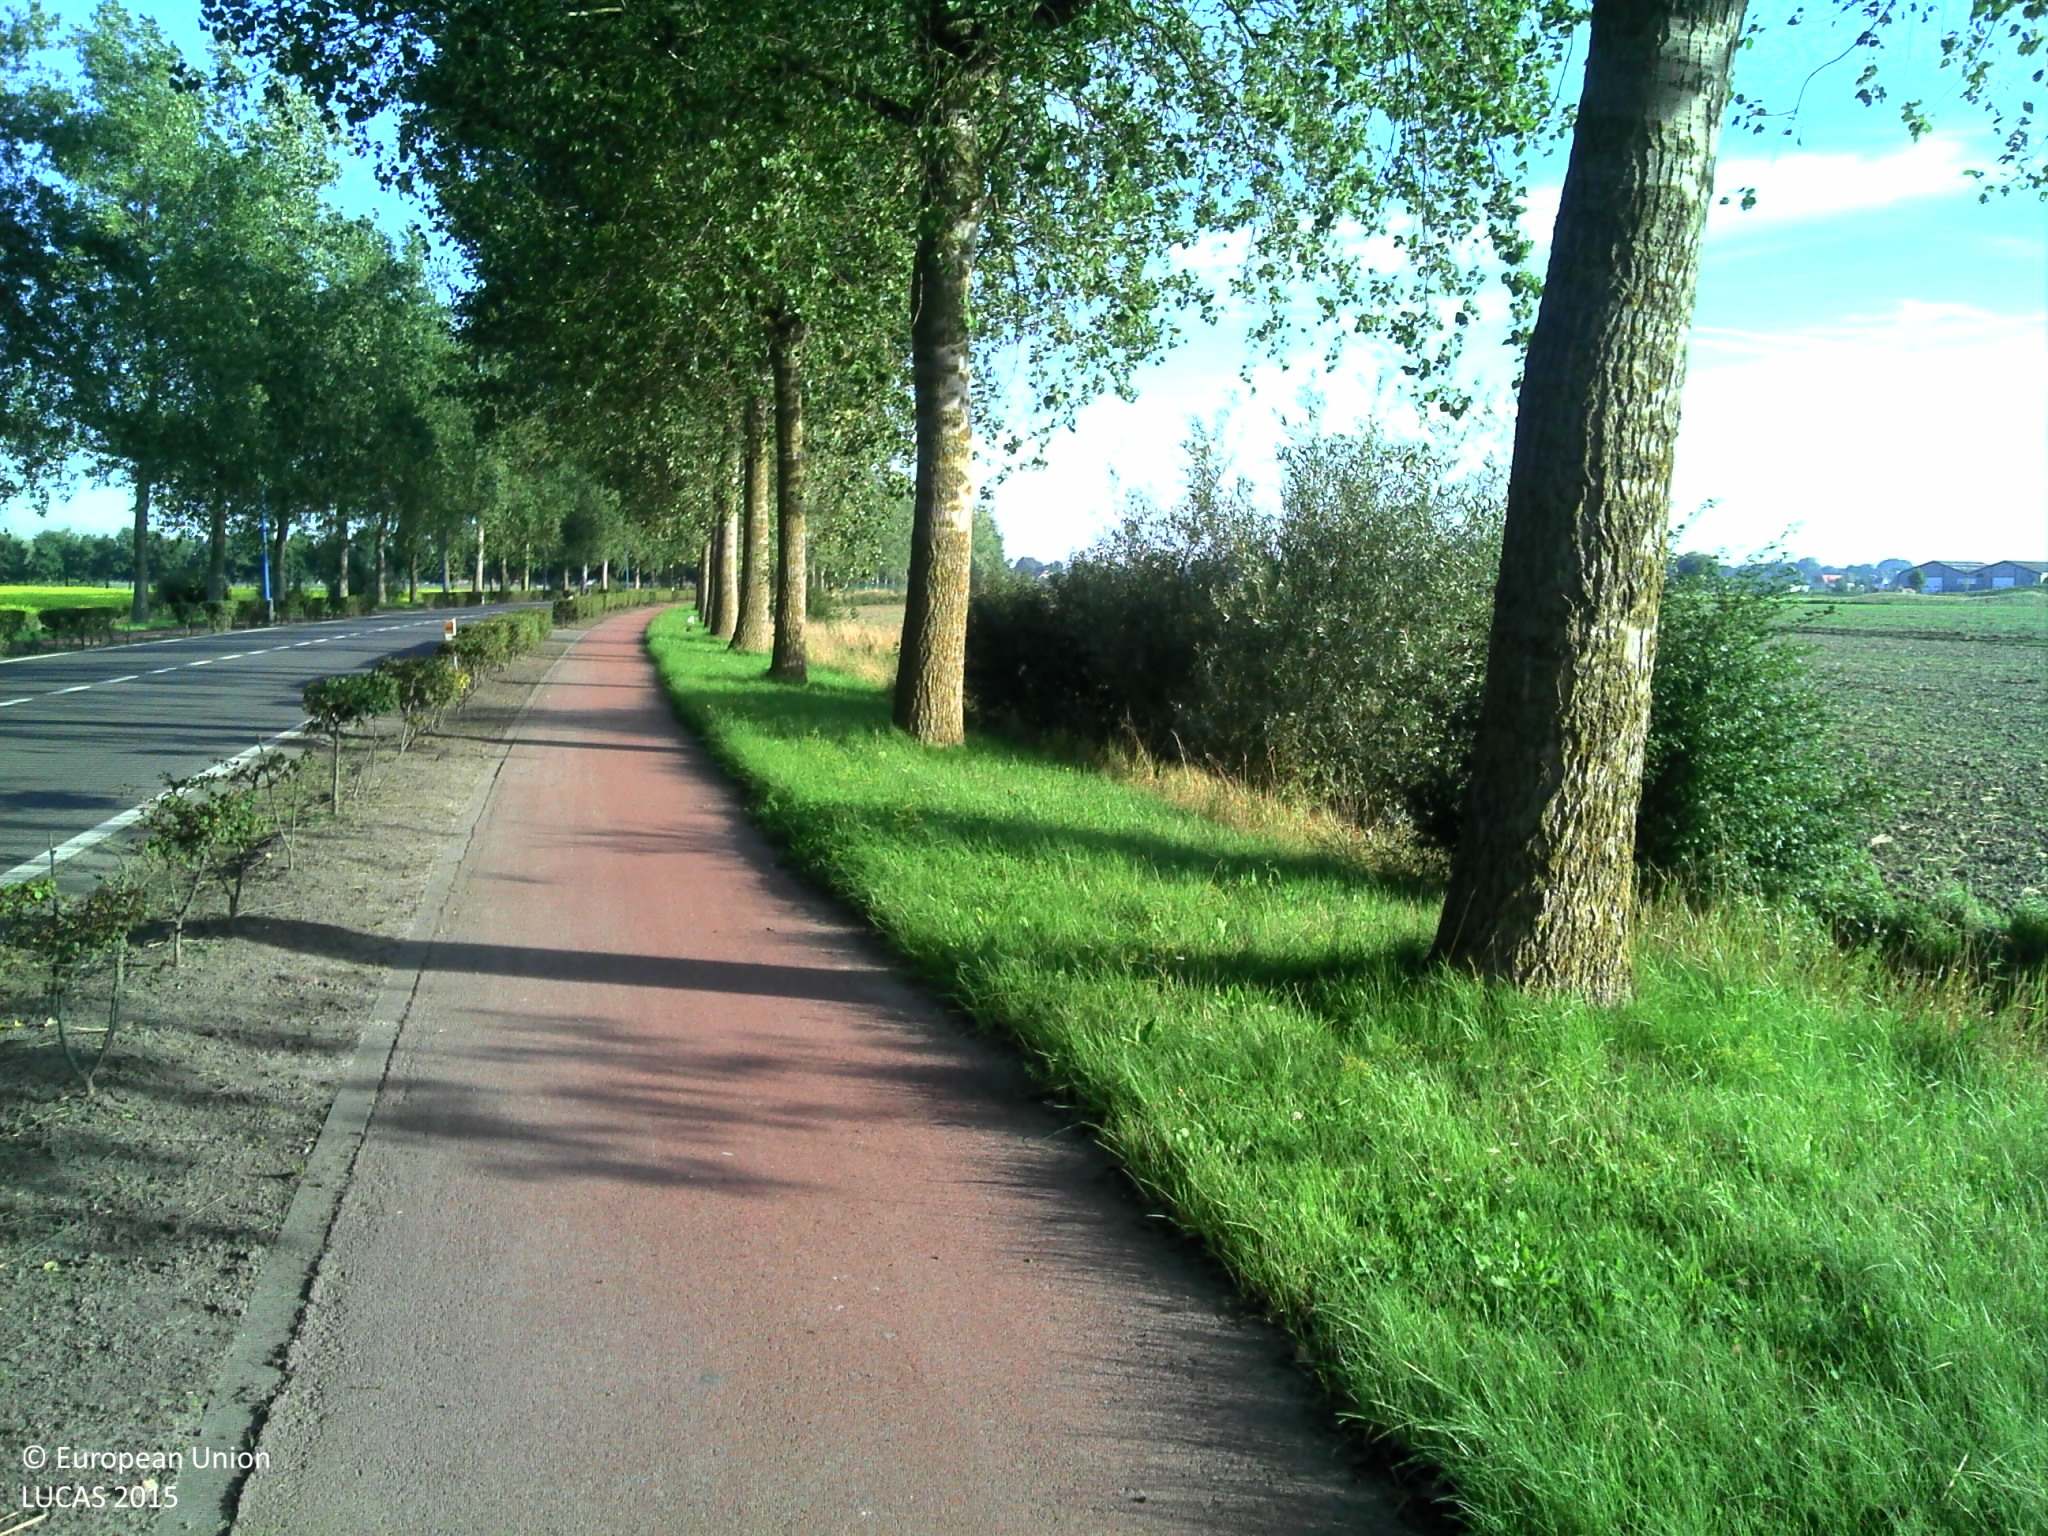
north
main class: Woodland
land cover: Broadleaved woodland
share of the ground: > 75 %
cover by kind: broadleaved forest trees 80 %, herbaceous plants 20 %
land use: Road transport
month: September
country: BE
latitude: 51.1050
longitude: 2.6901
